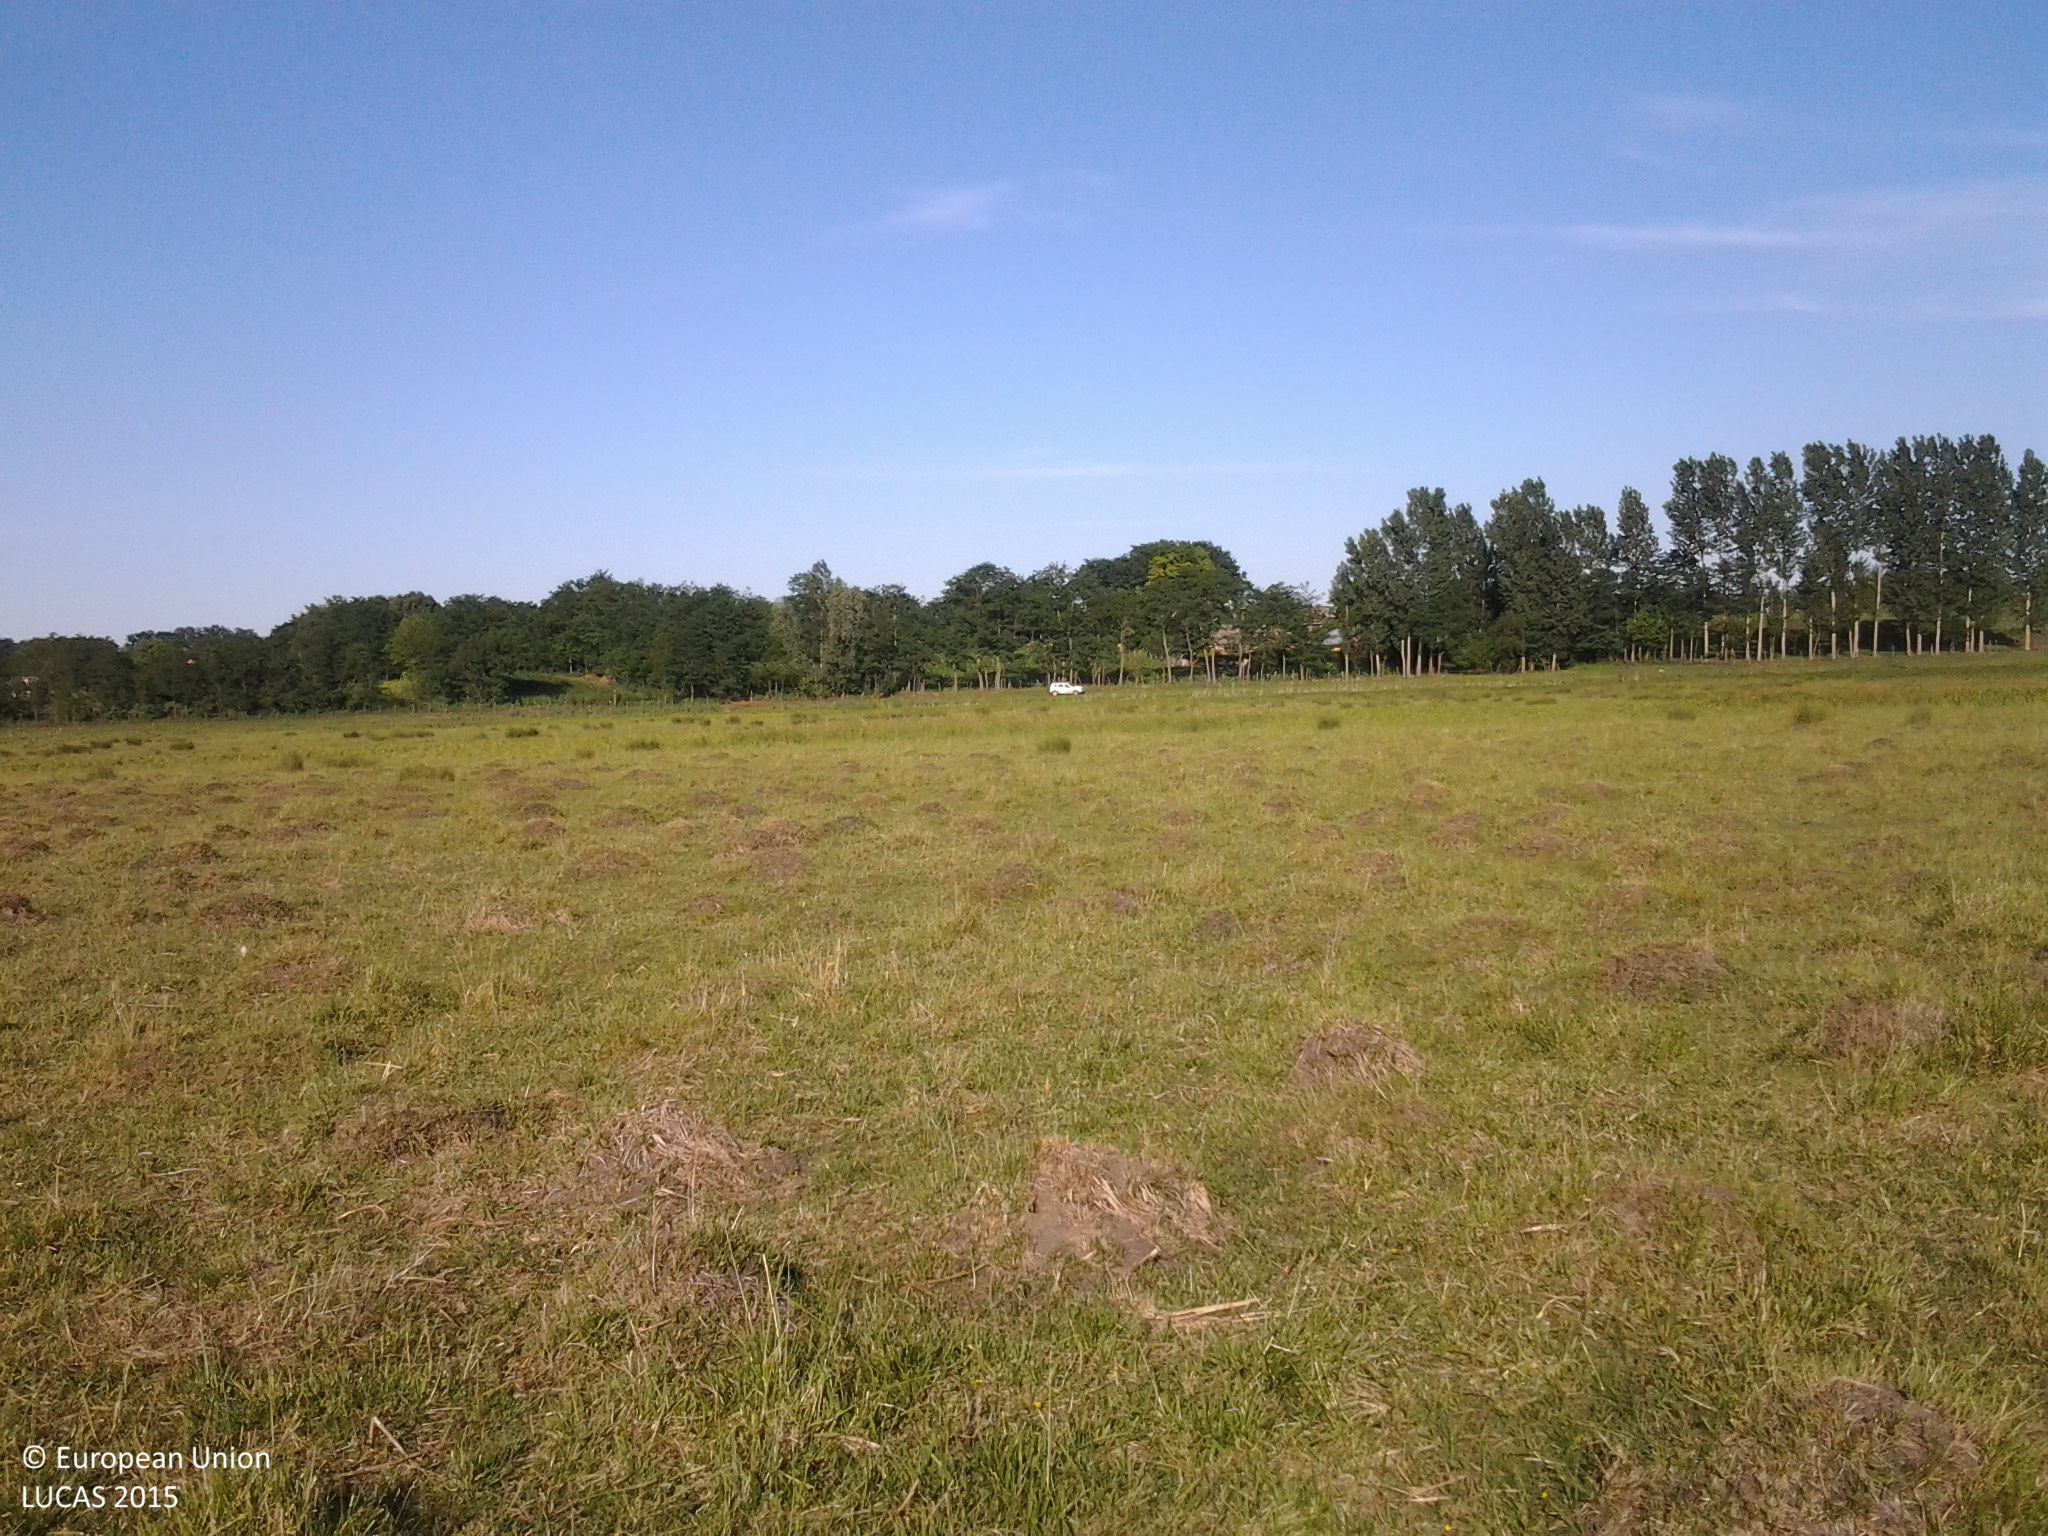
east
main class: Grassland
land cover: Grassland without tree/shrub cover
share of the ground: > 75 %
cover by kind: herbaceous plants 100 %
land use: Agriculture (excluding fallow land and kitchen gardens)
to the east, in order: Grassland without tree/shrub cover; Inland marshes; Grassland without tree/shrub cover
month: June
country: RO
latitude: 47.1555
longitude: 26.8333
